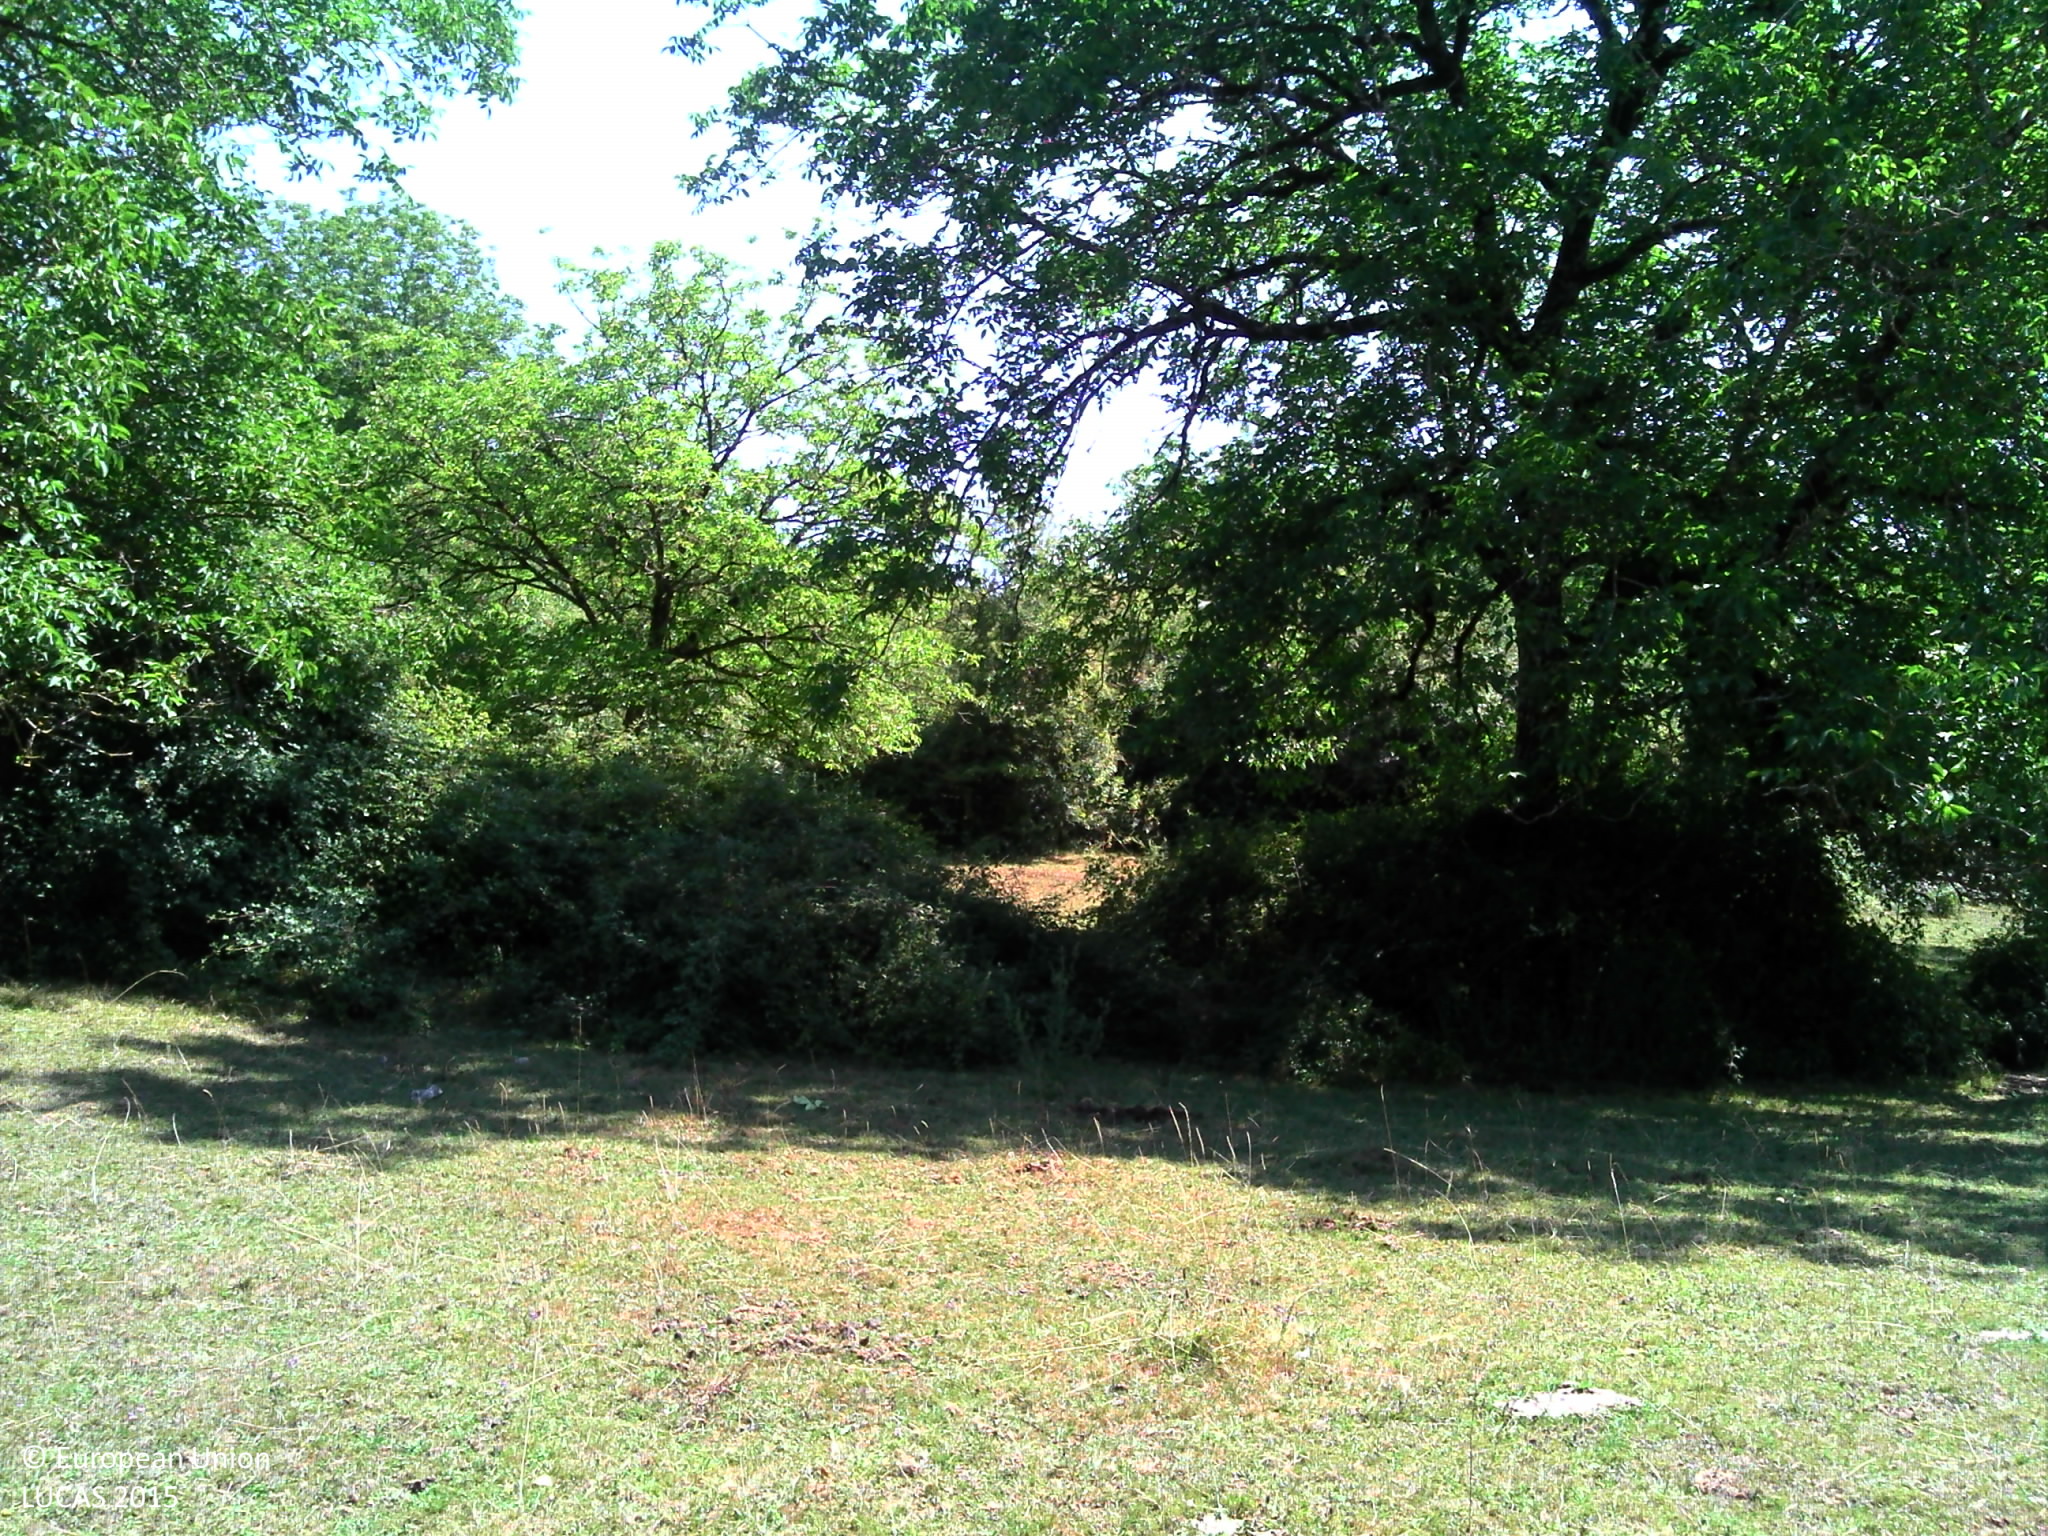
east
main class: Grassland
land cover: Grassland without tree/shrub cover
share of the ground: > 75 %
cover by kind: herbaceous plants 100 %
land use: Agriculture (excluding fallow land and kitchen gardens)
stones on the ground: < 10 %
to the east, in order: Grassland without tree/shrub cover; Broadleaved woodland; Grassland without tree/shrub cover; Broadleaved woodland; Grassland without tree/shrub cover; Abandoned hedges; Grassland with sparse tree/shrub cover; Artificial constructions in urban areas
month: August
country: FR
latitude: 45.3586
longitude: 1.0427
